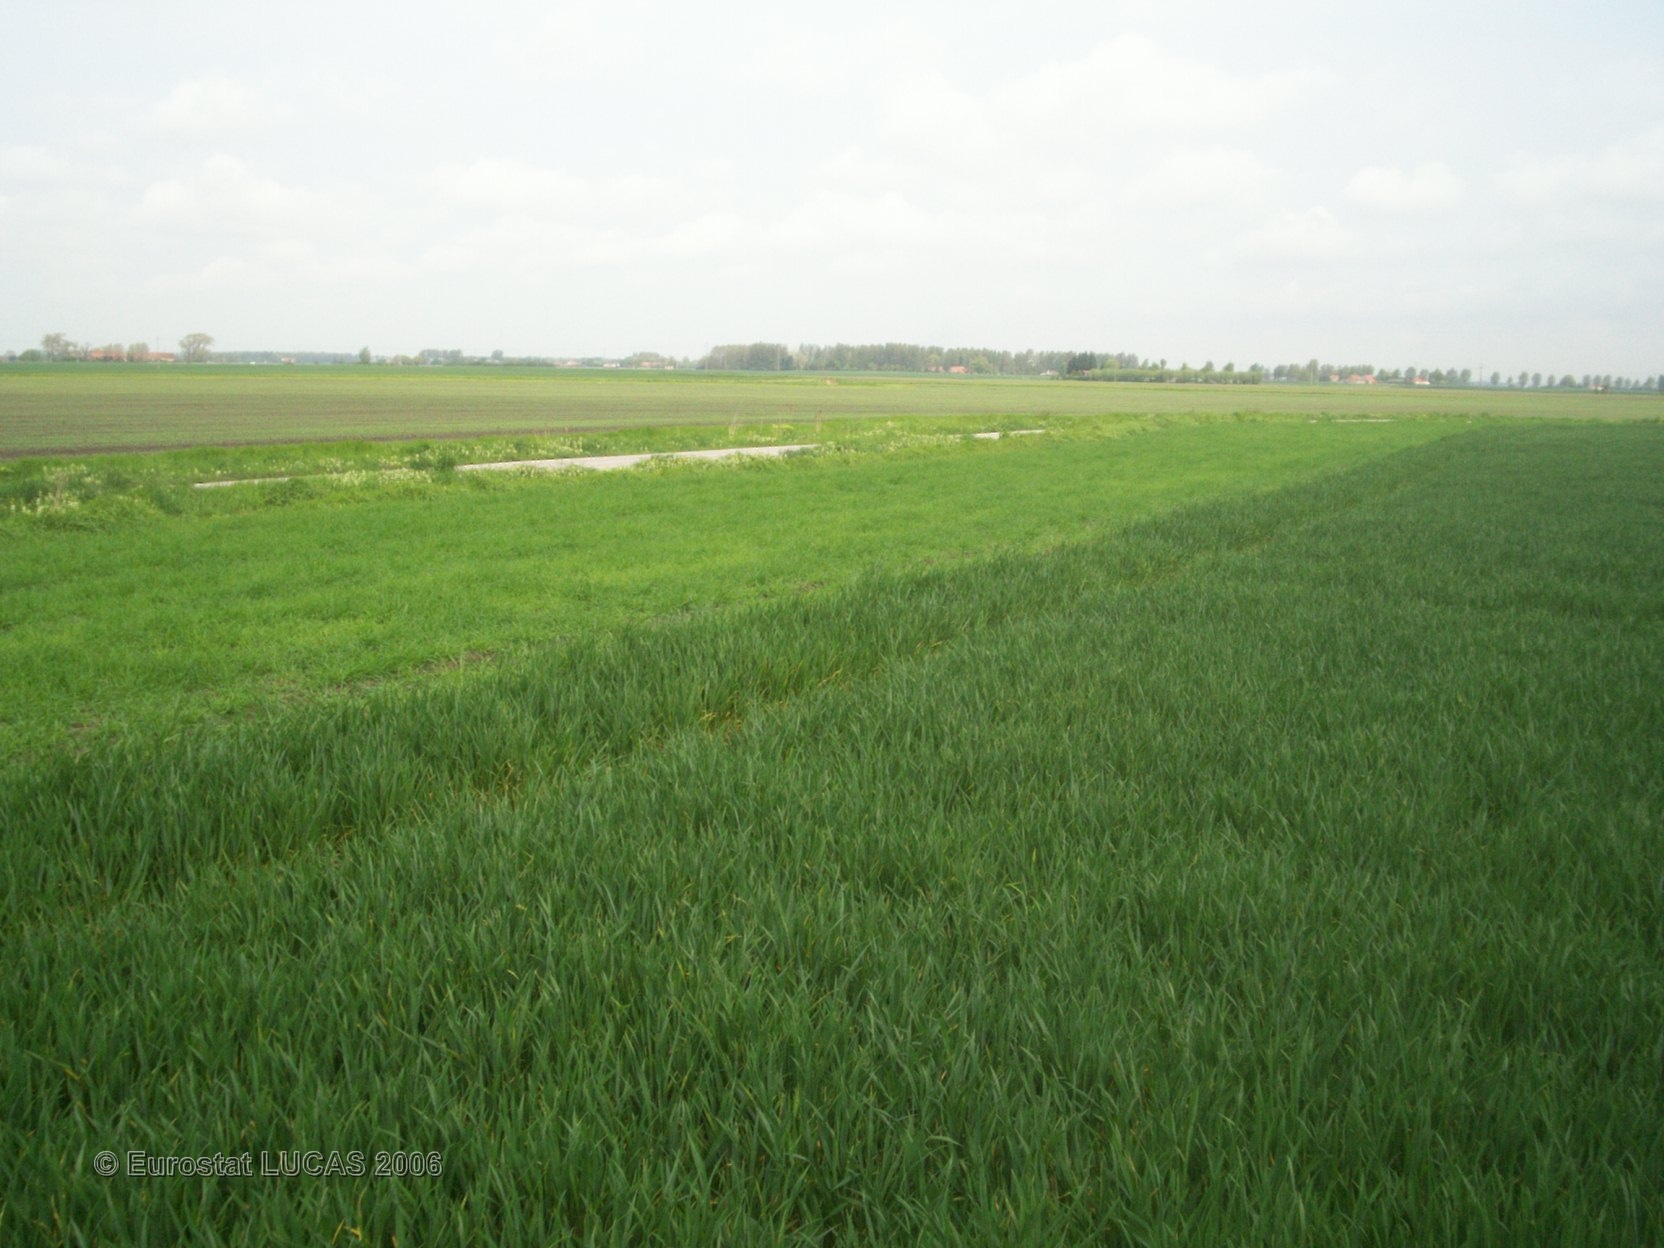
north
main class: Cropland
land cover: Common wheat
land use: Agriculture (excluding fallow land and kitchen gardens)
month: May
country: FR
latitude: 50.9165
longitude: 2.2907
